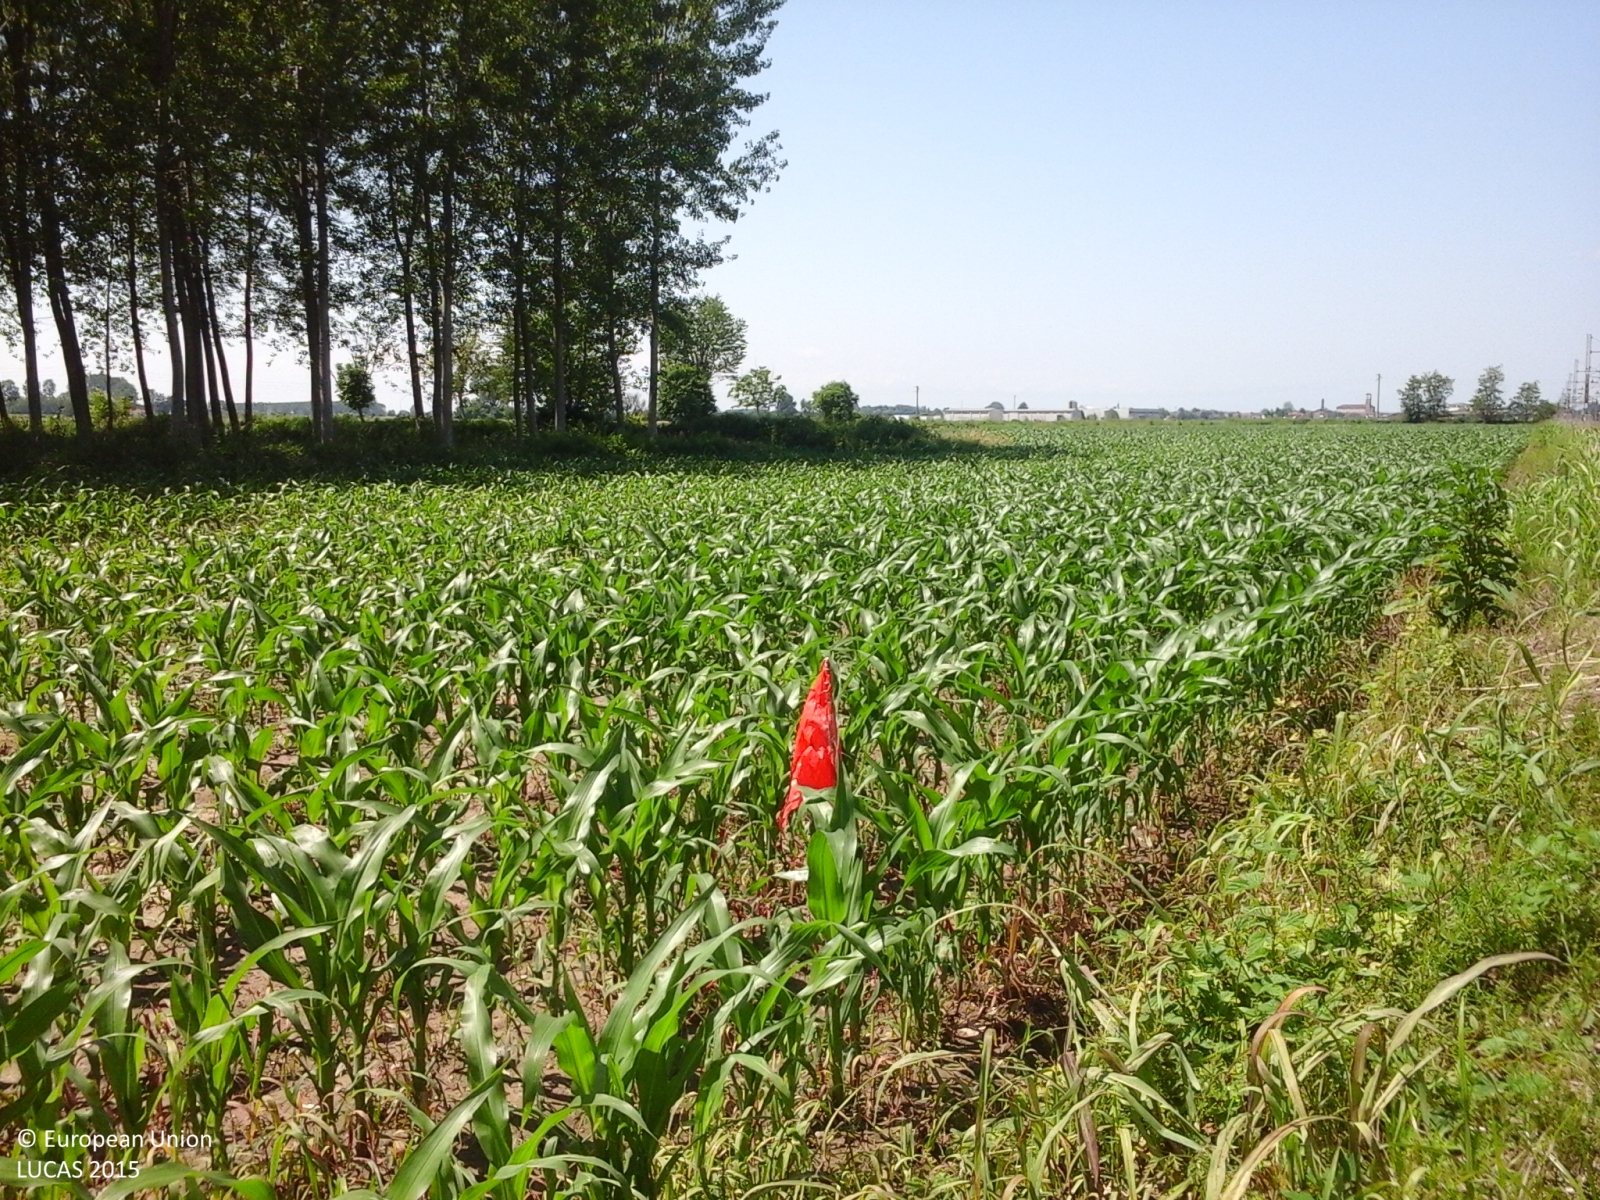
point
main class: Cropland
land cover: Maize
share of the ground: 50 - 75 %
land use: Agriculture (excluding fallow land and kitchen gardens)
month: May
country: IT
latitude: 45.2983
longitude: 8.7143
